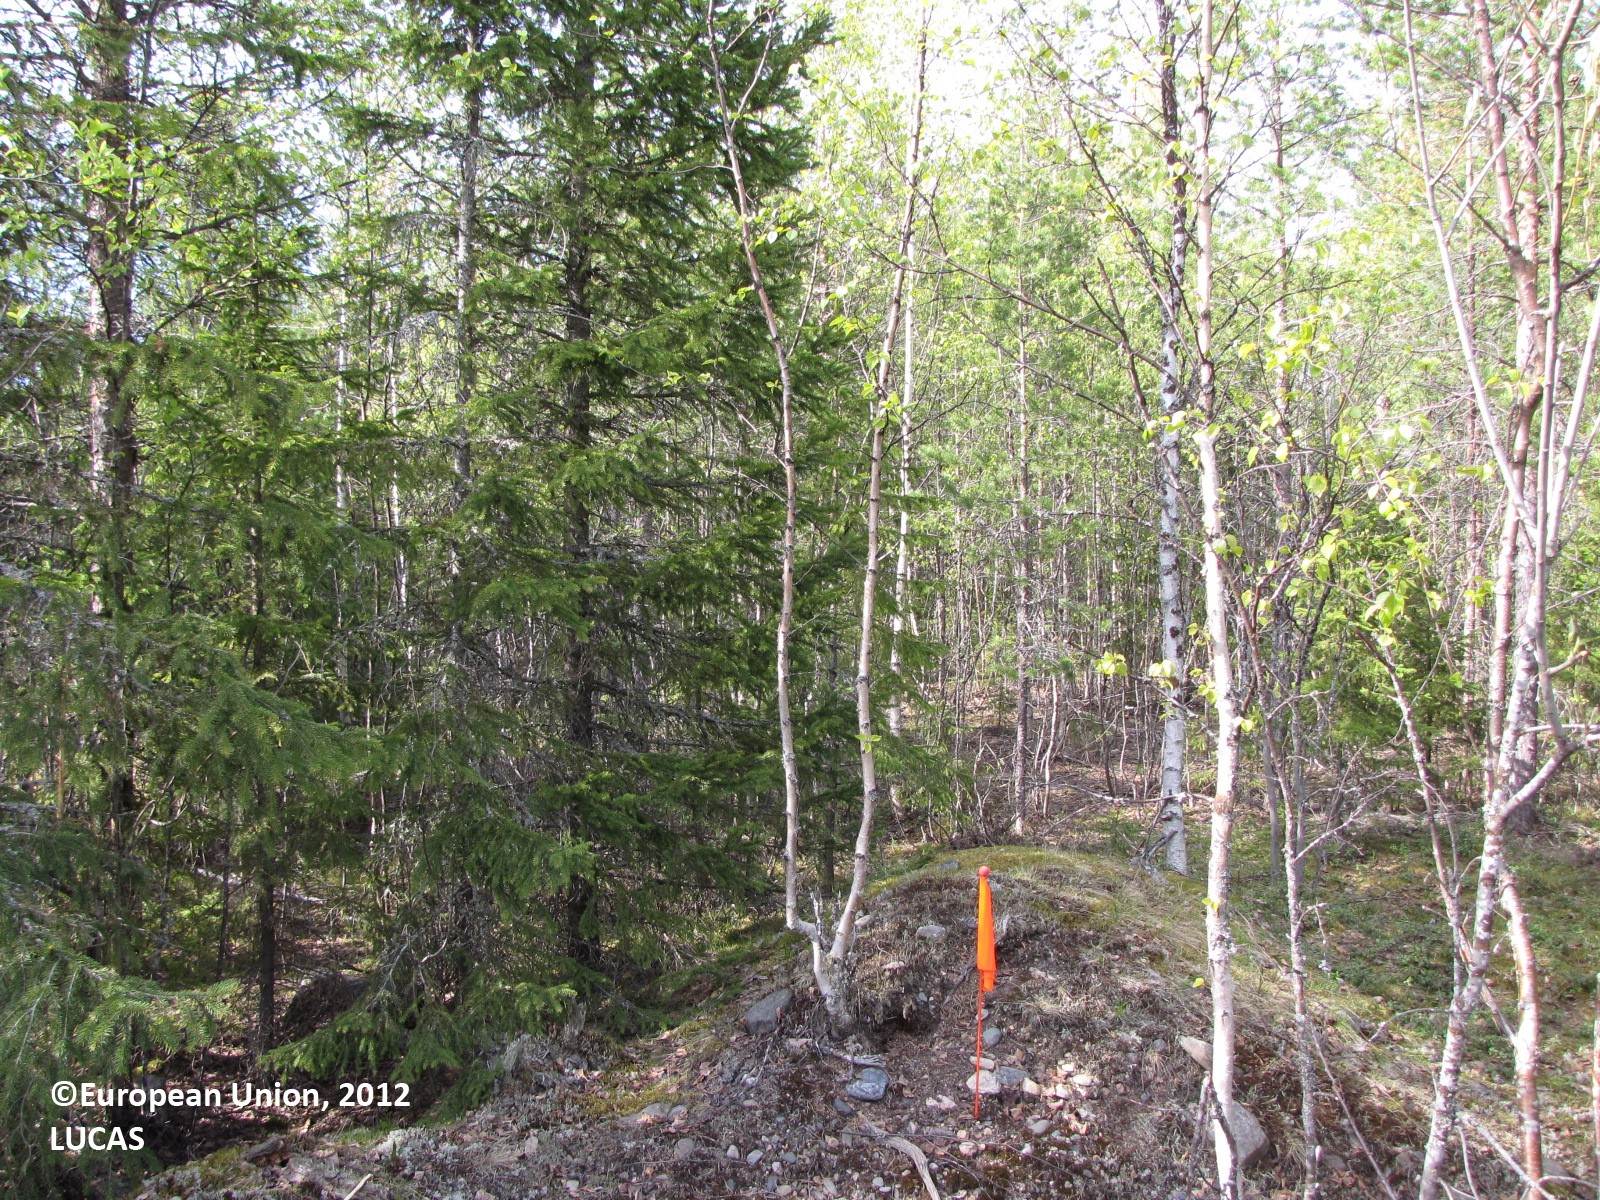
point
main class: Woodland
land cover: Spruce dominated mixed woodland
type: boreal forest
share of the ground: > 75 %
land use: Forestry
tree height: > 5 m
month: May
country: FI
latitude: 65.7959
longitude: 24.6806
